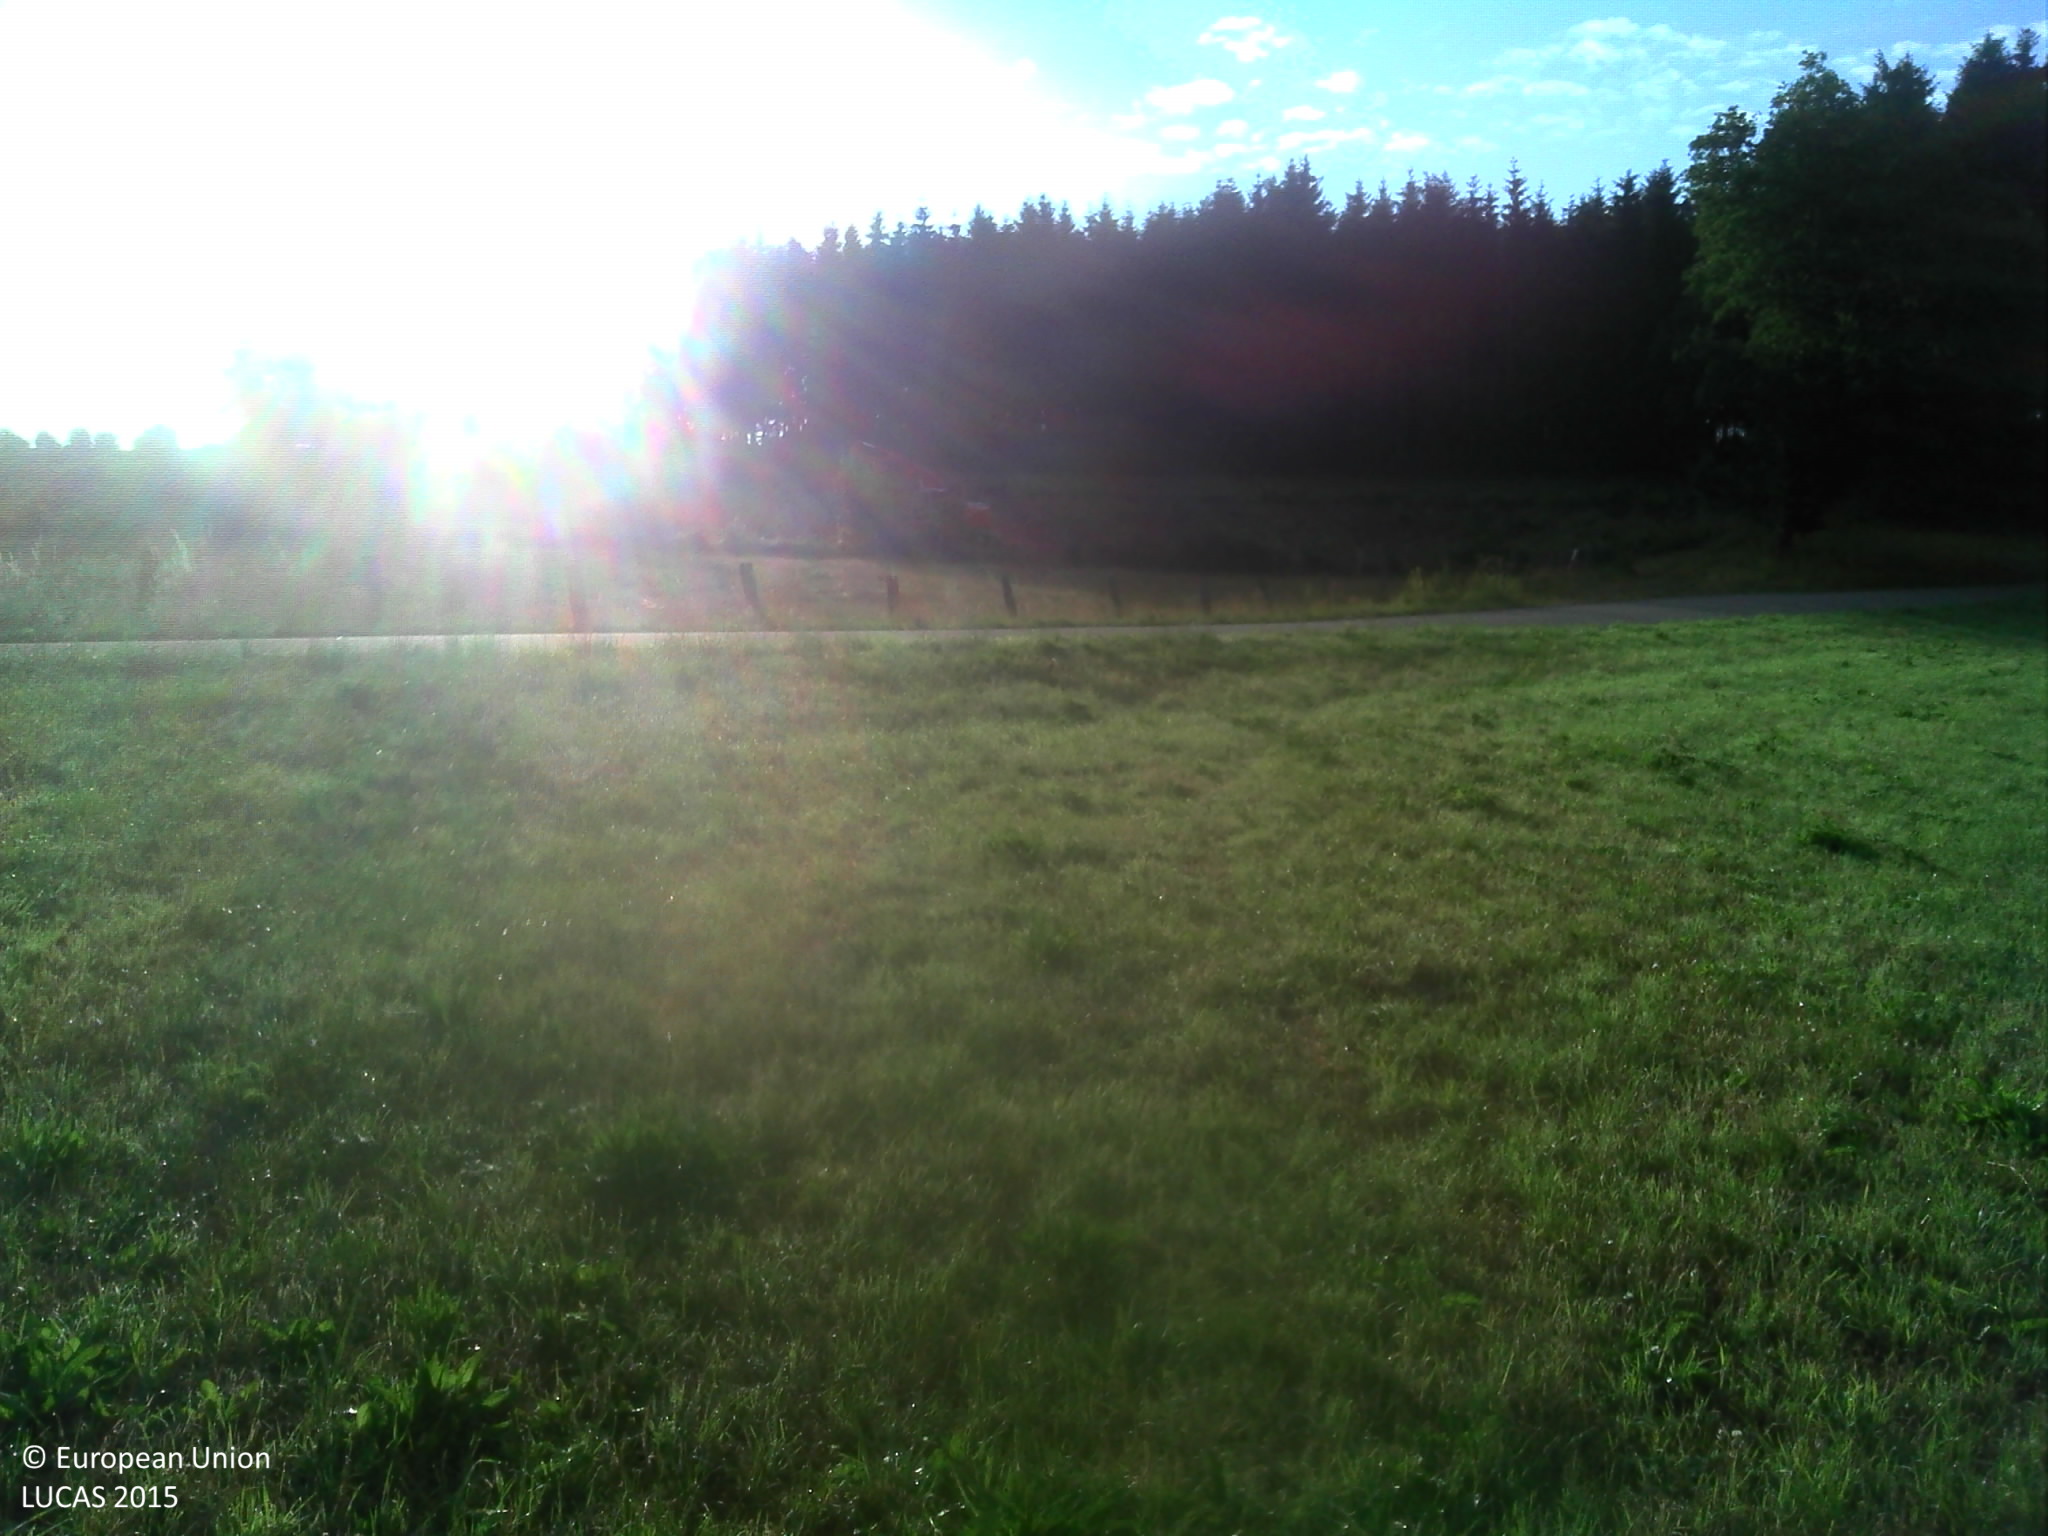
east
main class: Grassland
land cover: Grassland without tree/shrub cover
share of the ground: > 75 %
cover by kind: herbaceous plants 100 %
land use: Agriculture (excluding fallow land and kitchen gardens)
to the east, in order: Grassland without tree/shrub cover; Paved roads, cycling and walking lanes; Grass margins; Fences; Grassland without tree/shrub cover; Fences; Other bare soil; Spontaneously vegetated surfaces; Fences; Grassland without tree/shrub cover; Fences; Spruce dominated coniferous woodland; Grass margins; Paved roads, cycling and walking lanes; Grass margins; Abandoned hedges; Grassland without tree/shrub cover; Fences; Spruce dominated coniferous woodland
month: July
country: BE
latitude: 49.8021
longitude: 5.3715
